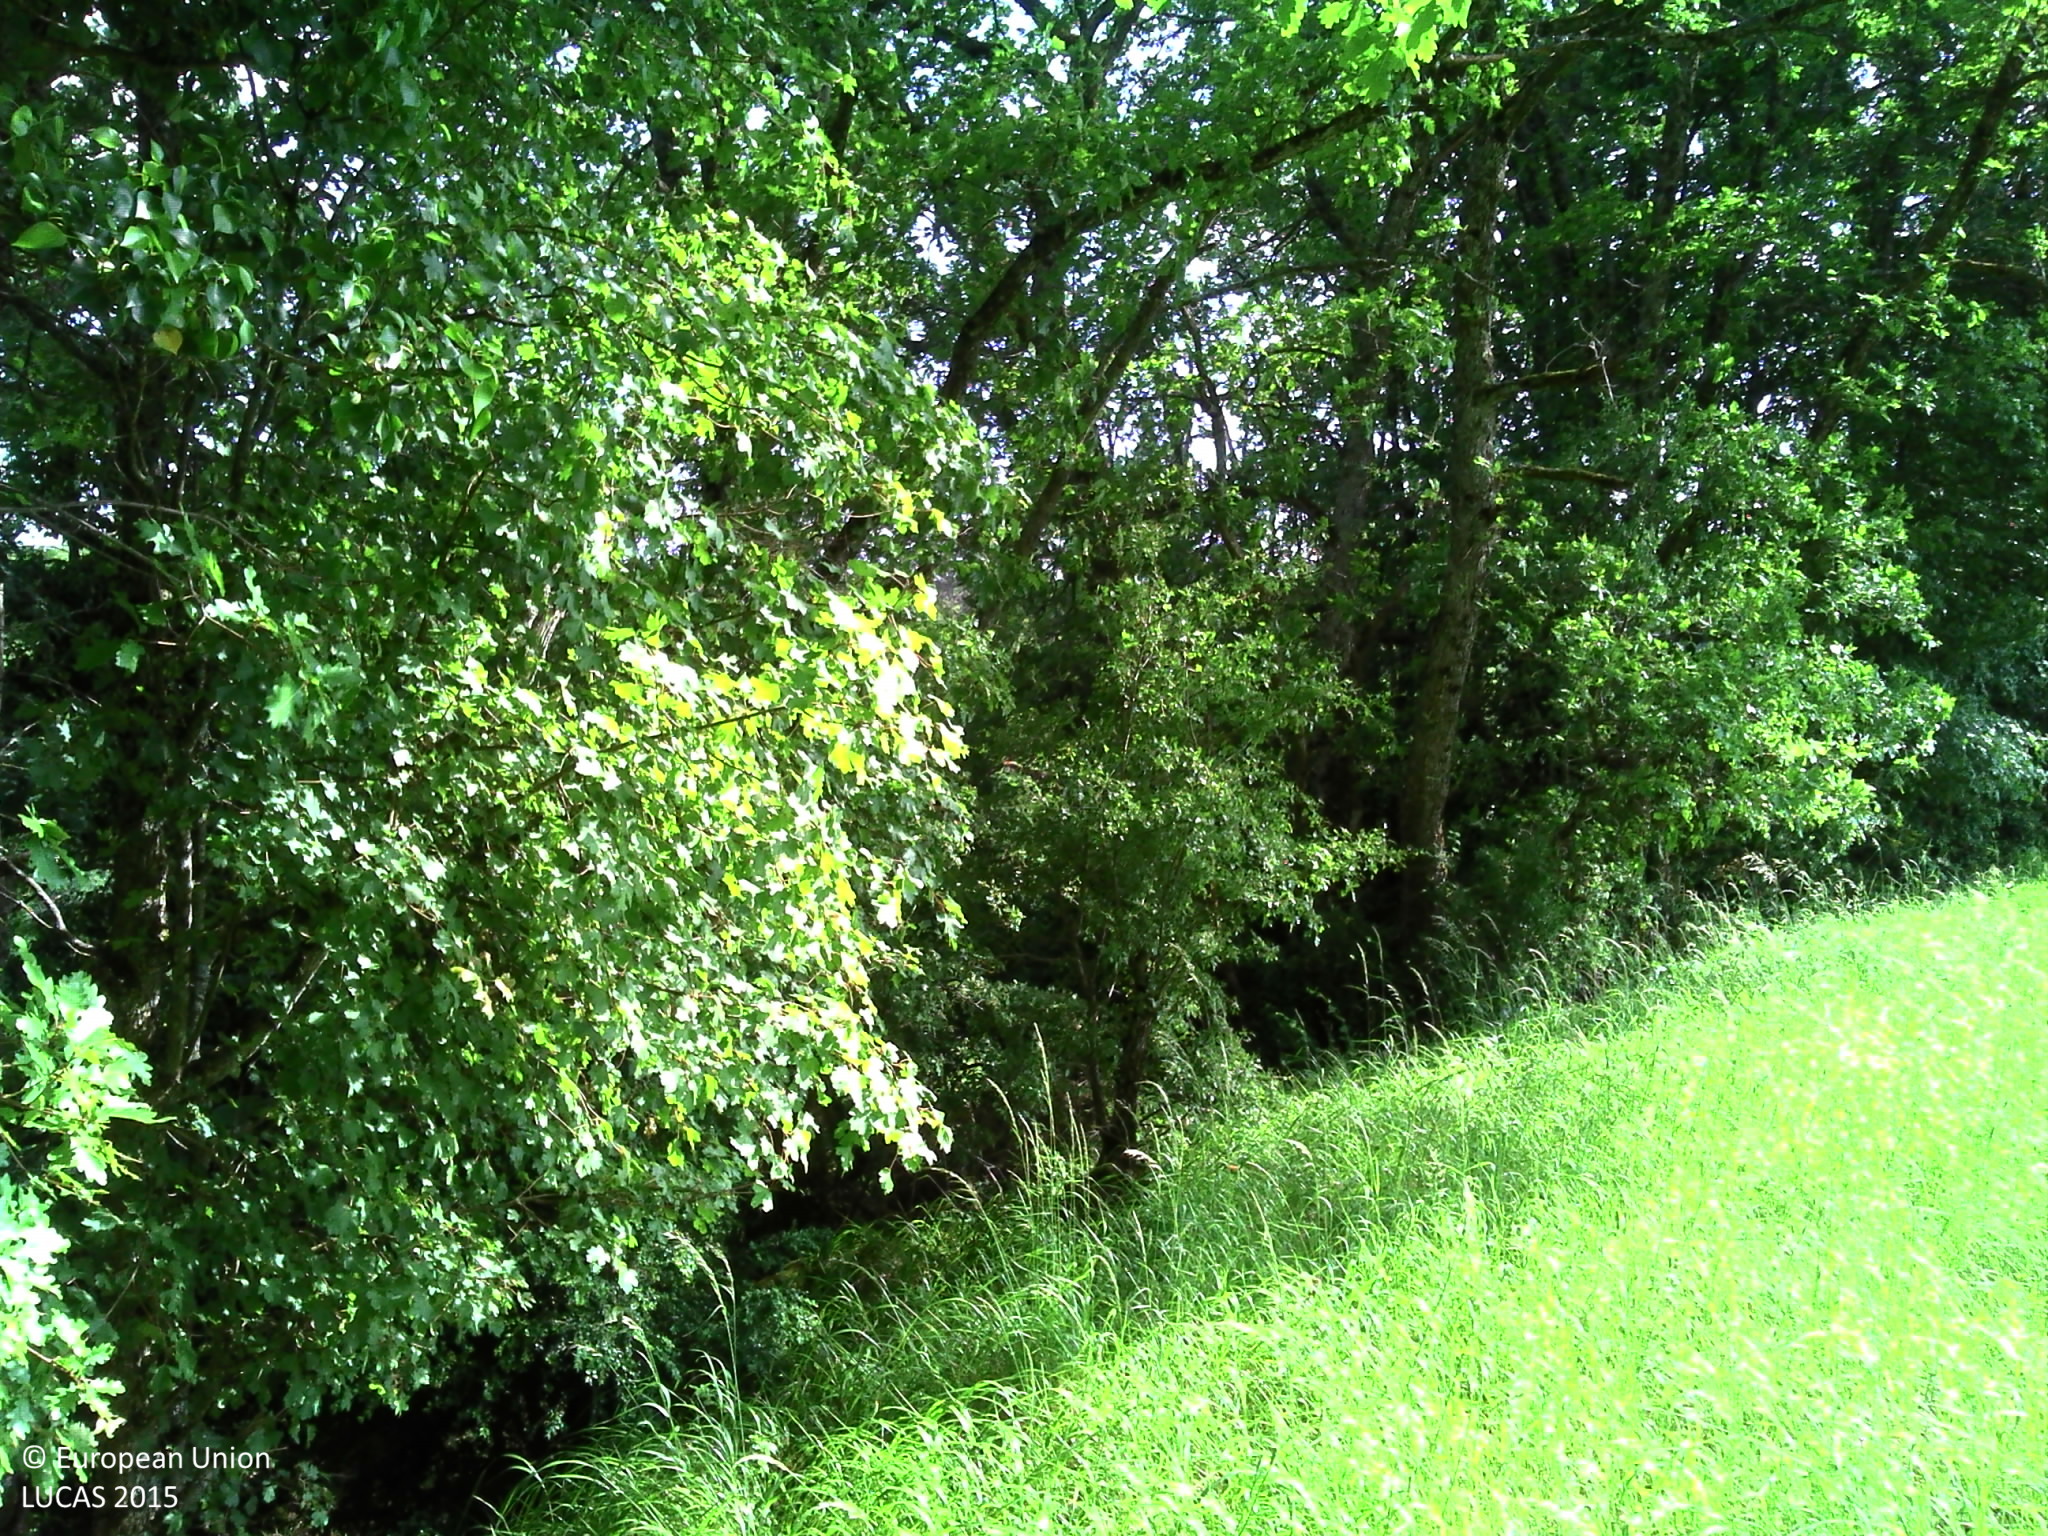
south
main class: Woodland
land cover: Broadleaved woodland
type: mesophytic deciduous forest
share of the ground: > 75 %
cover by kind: broadleaved forest trees 90 %, shrubs 10 %
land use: Forestry
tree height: > 5 m
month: May
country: FR
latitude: 47.2969
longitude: 4.9619
